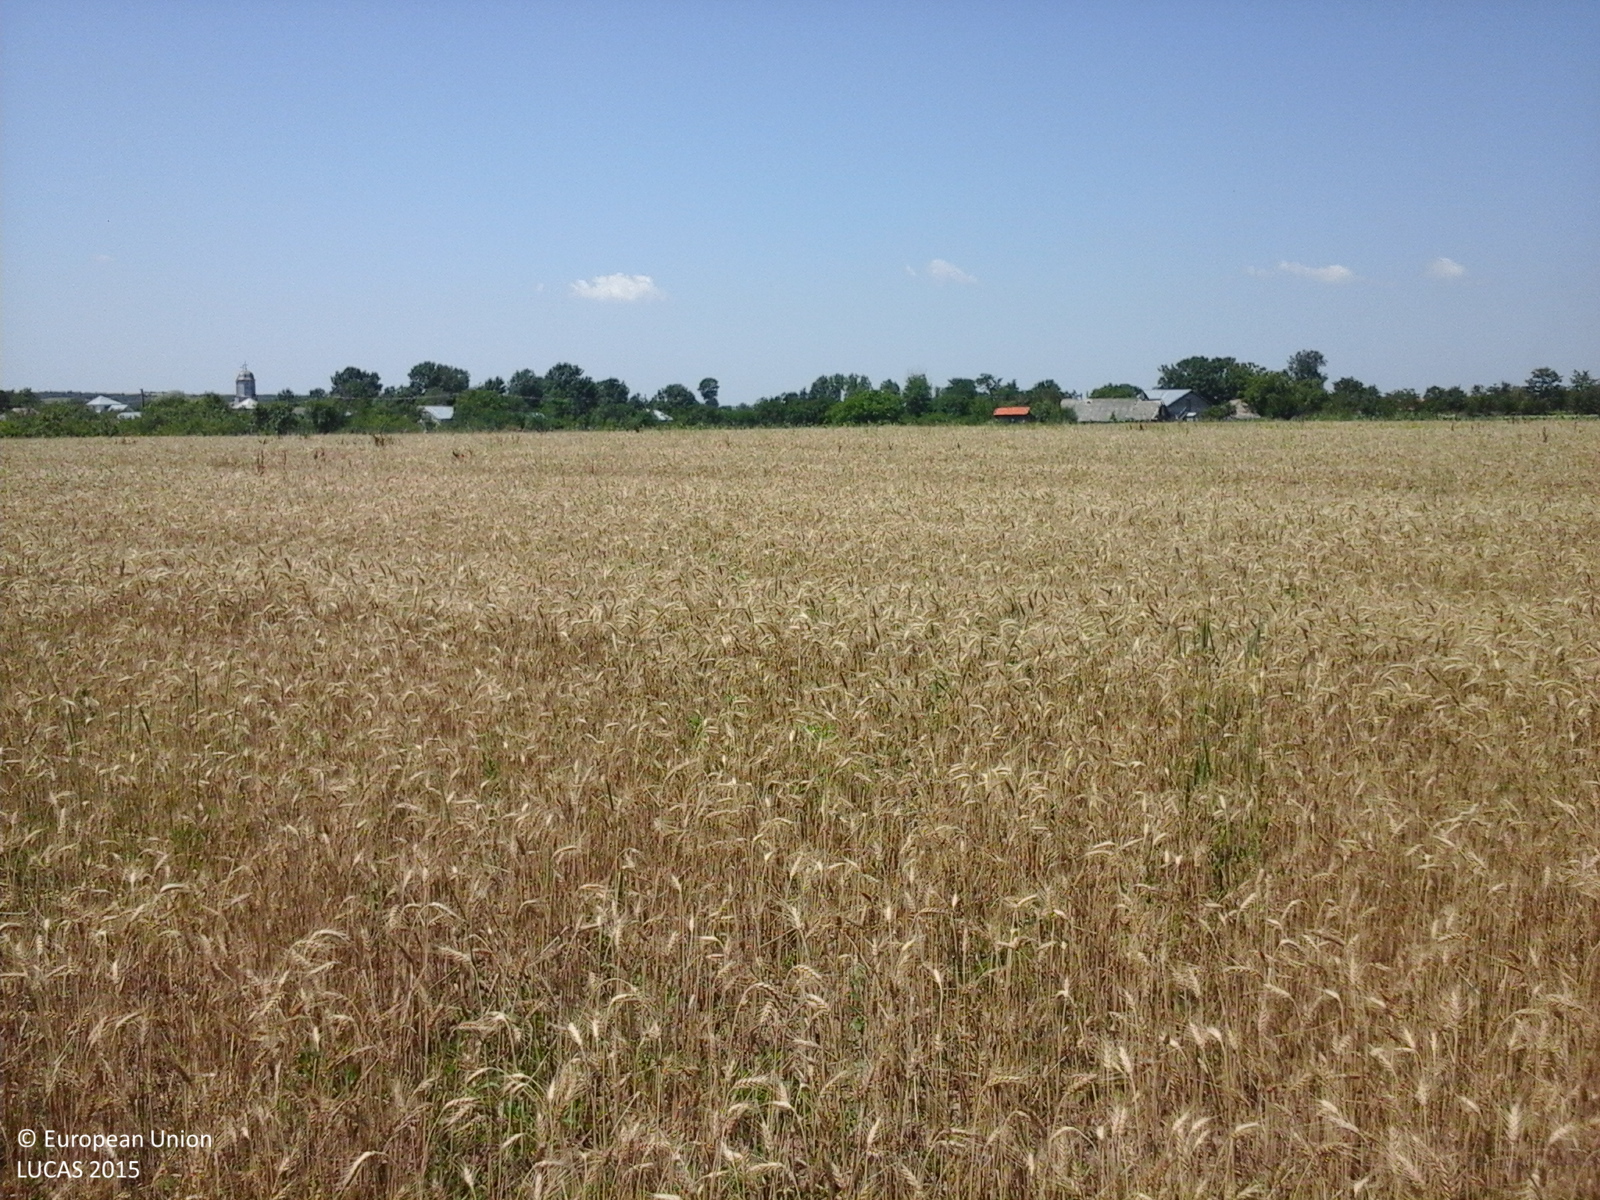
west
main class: Cropland
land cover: Common wheat
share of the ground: > 75 %
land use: Agriculture (excluding fallow land and kitchen gardens)
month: July
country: RO
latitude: 44.4765
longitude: 24.6445
